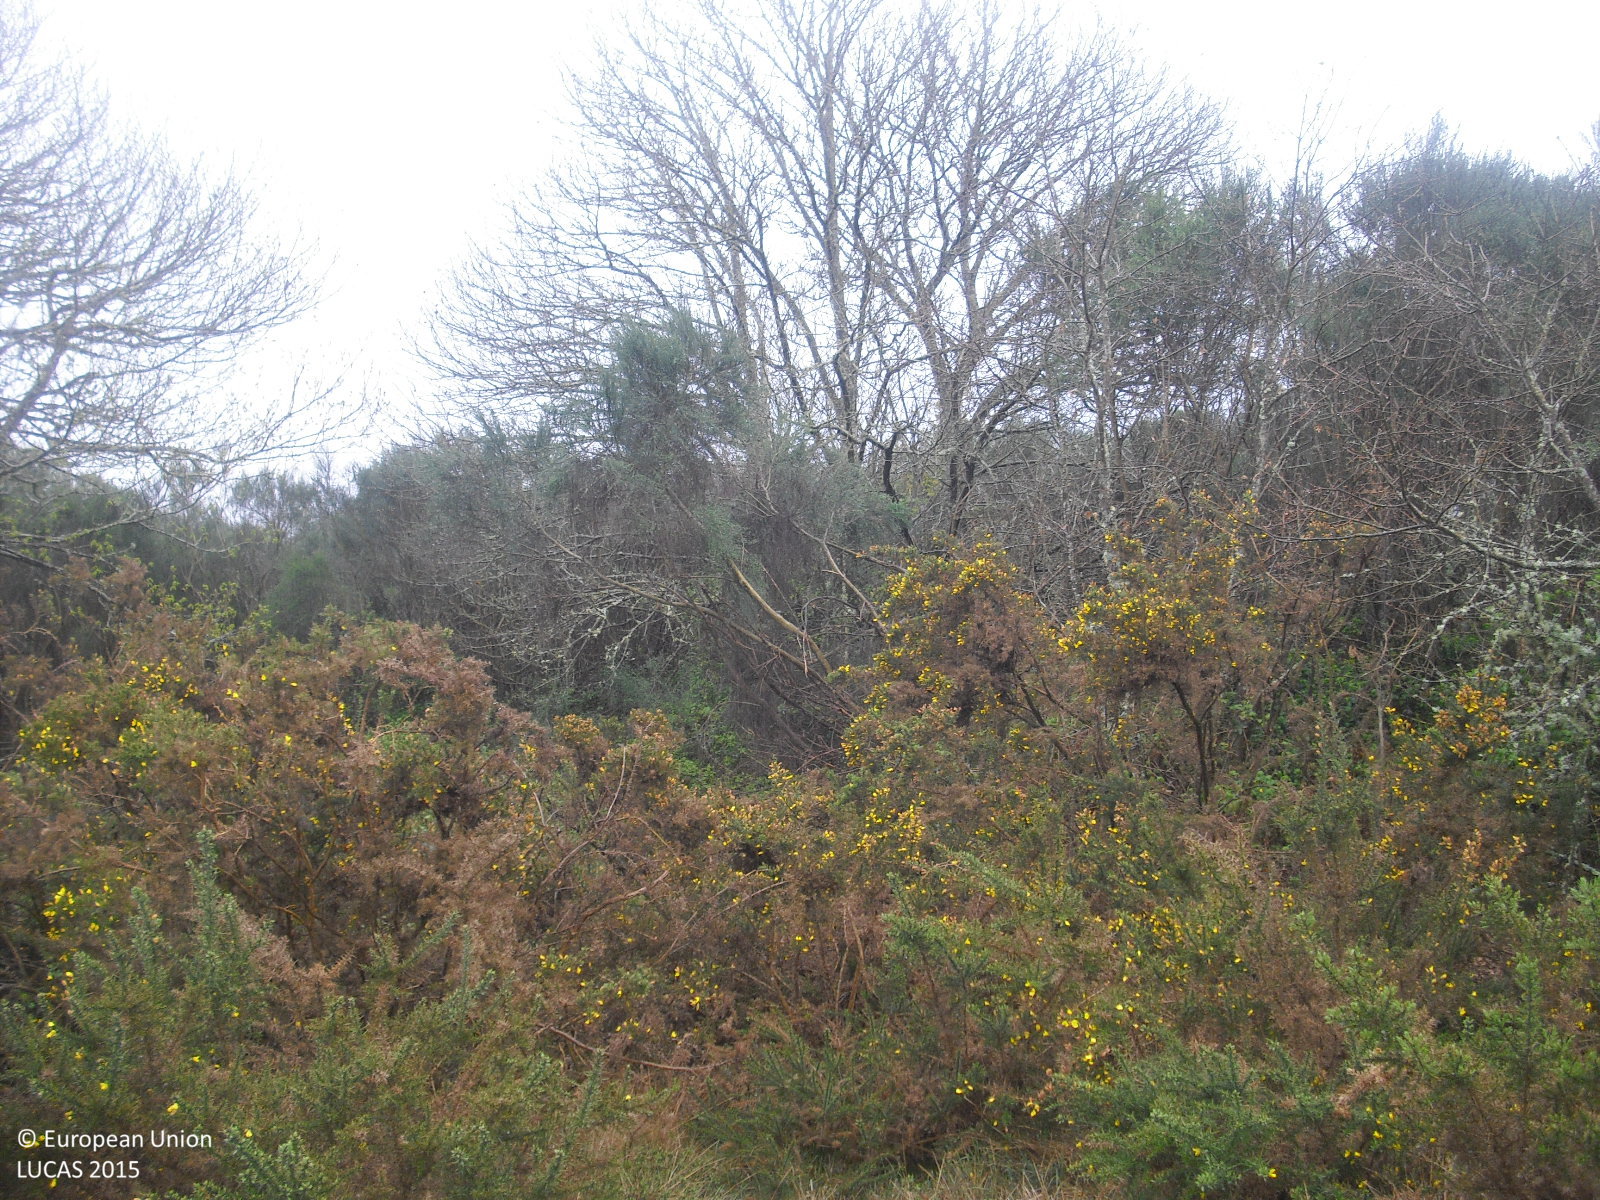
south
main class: Shrubland
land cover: Shrubland with sparse tree cover
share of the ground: 50 - 75 %
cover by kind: shrubs 85 %, herbaceous plants 10 %, broadleaved forest trees 5 %
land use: Abandoned areas
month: April
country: ES
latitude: 42.1203
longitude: -7.8668
